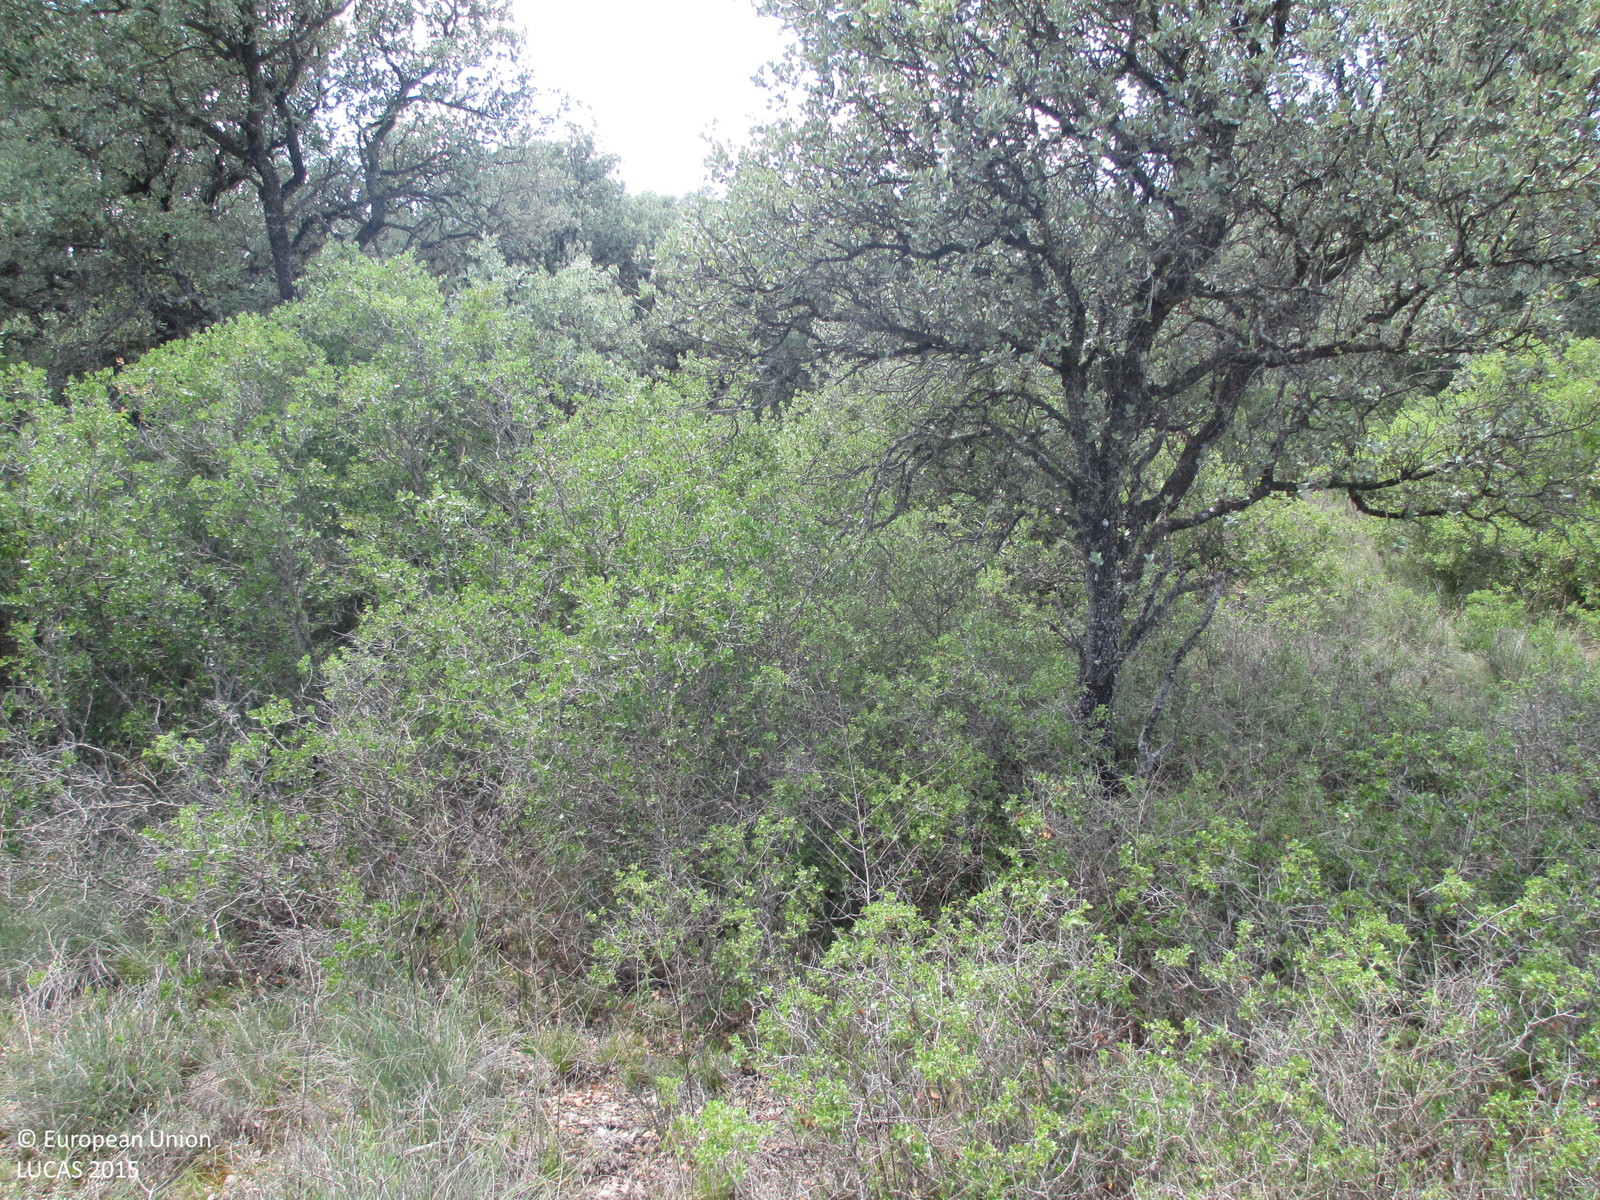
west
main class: Woodland
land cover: Broadleaved woodland
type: broadleaved evergreen forest
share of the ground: > 75 %
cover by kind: broadleaved forest trees 100 %
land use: Semi-natural and natural areas not in use
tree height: > 5 m
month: June
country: ES
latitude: 42.2004
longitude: -0.4752
